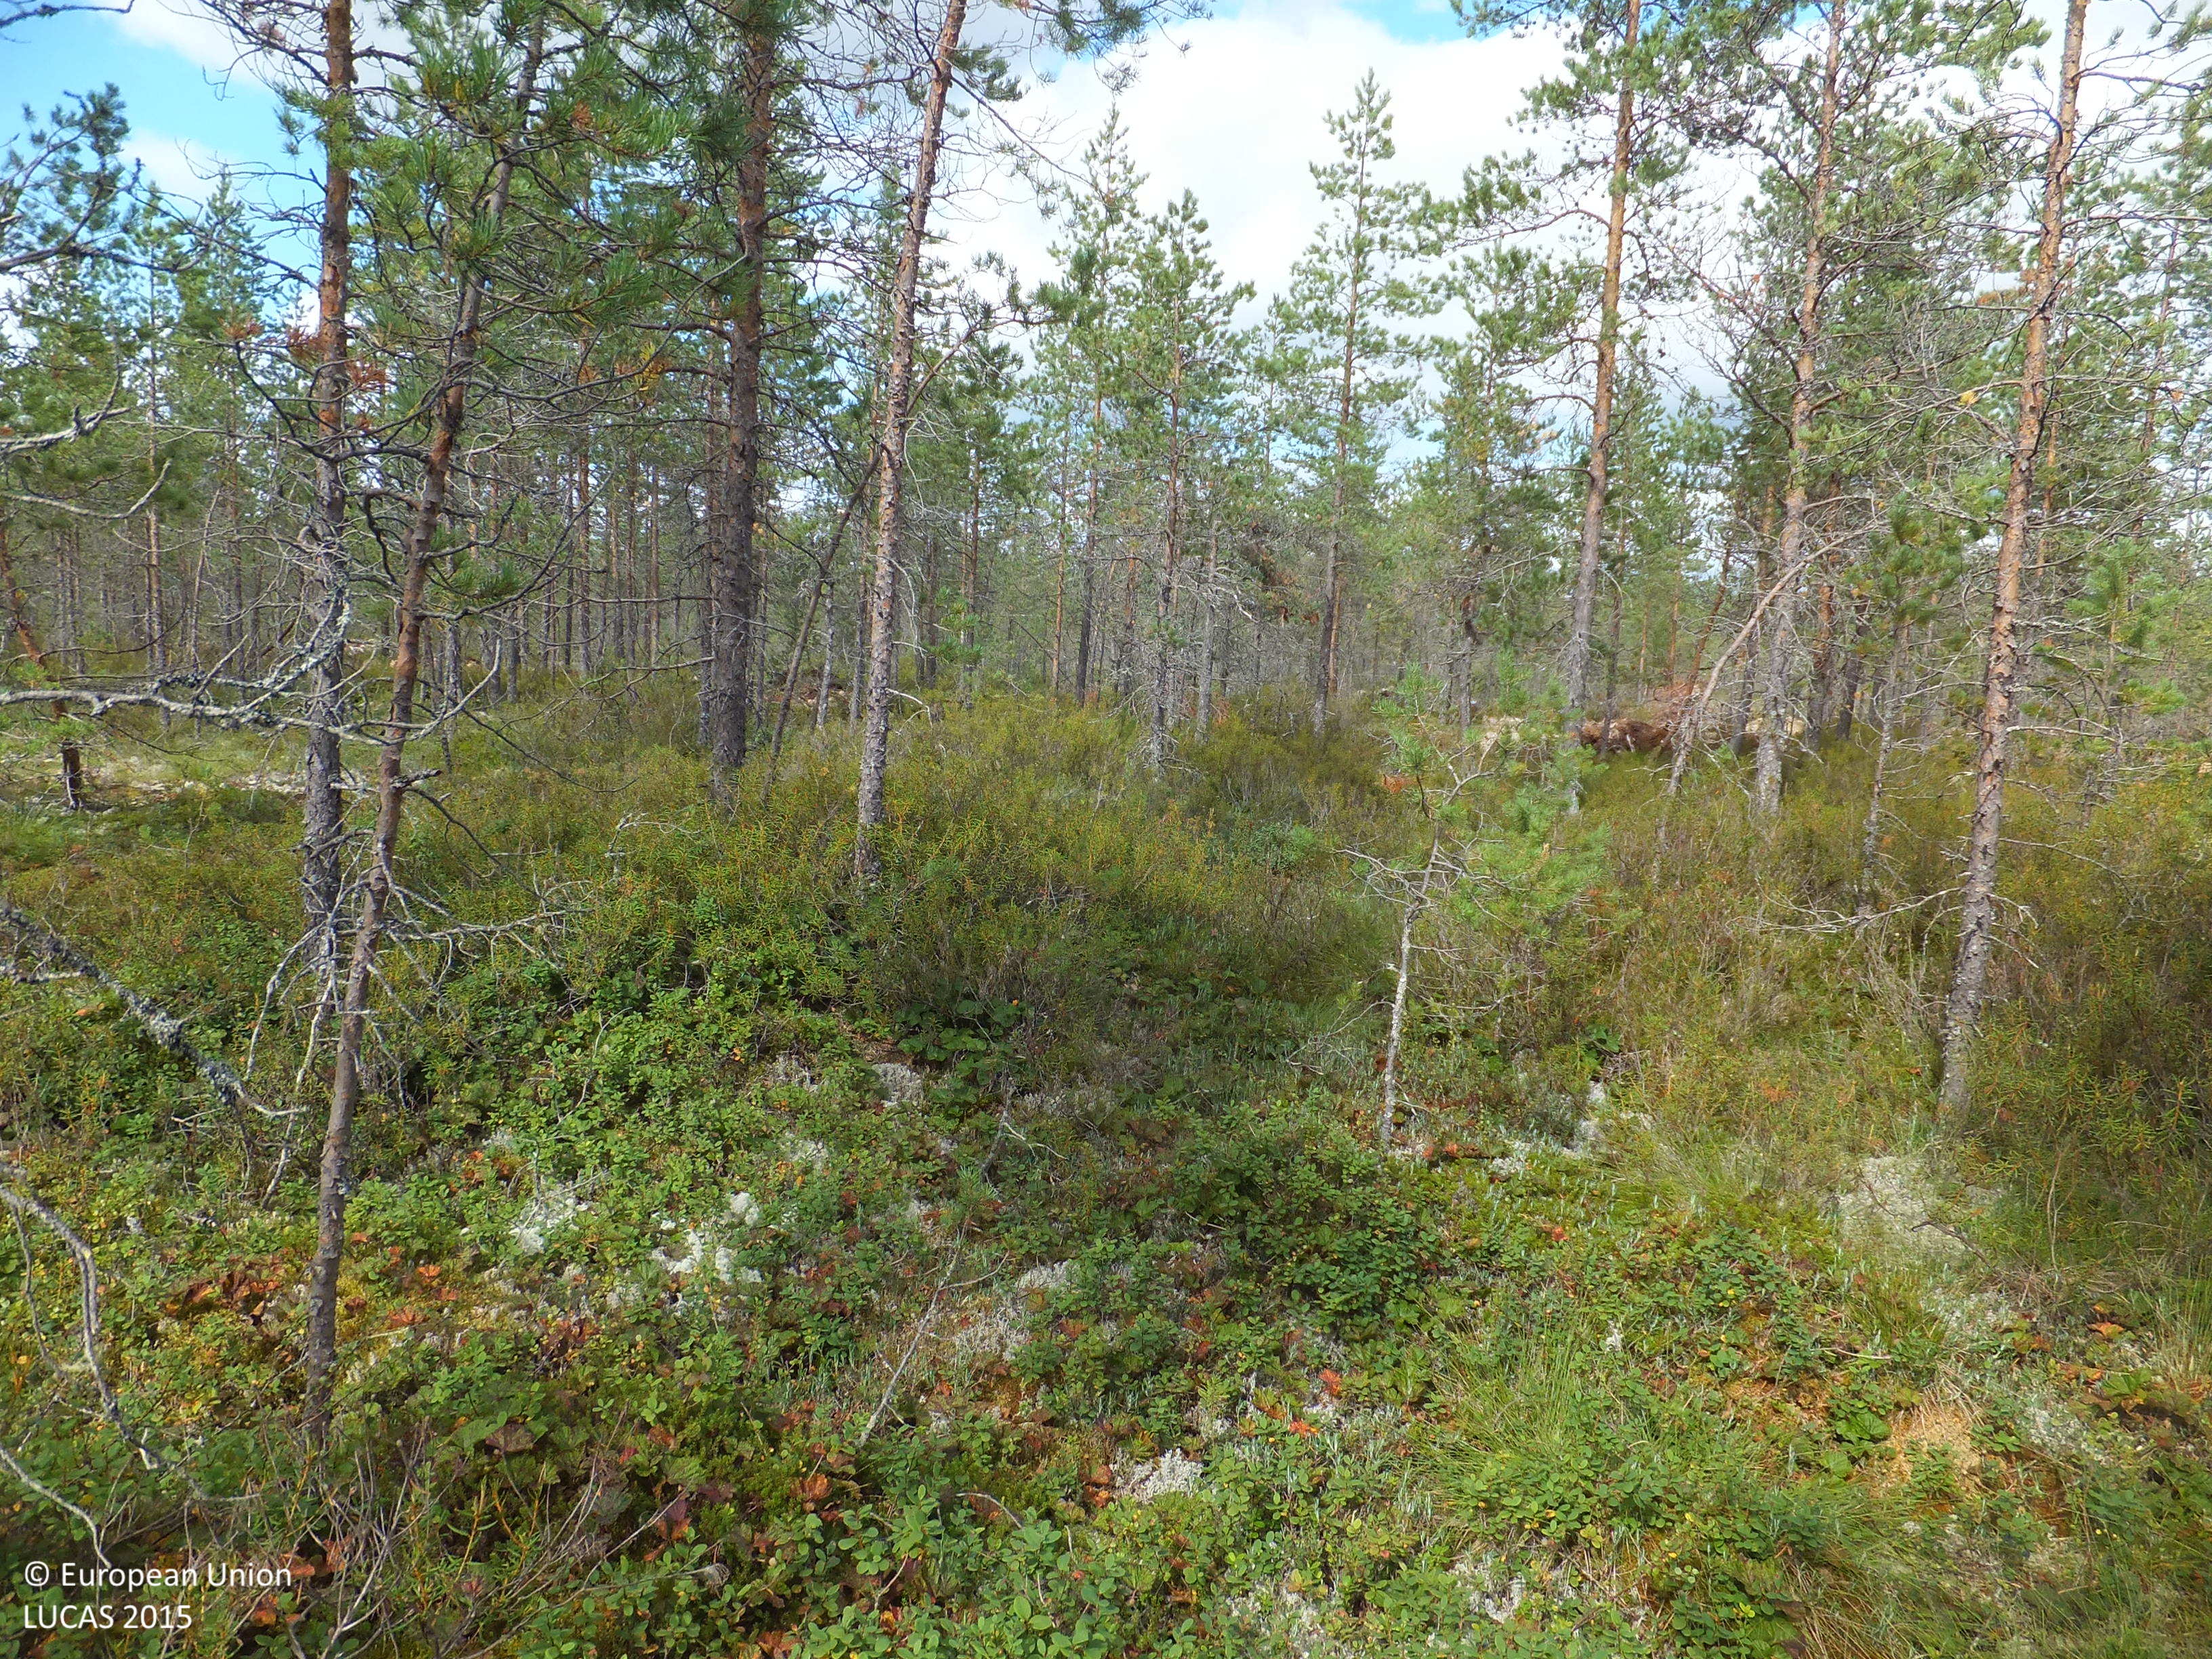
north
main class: Woodland
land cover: Pine dominated coniferous woodland
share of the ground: 25 - 50 %
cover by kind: coniferous forest trees 45 %, shrubs 25 %, lichens and mosses 20 %, herbaceous plants 10 %
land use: Forestry
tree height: < 5 m
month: August
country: FI
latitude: 63.2726
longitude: 23.4359
